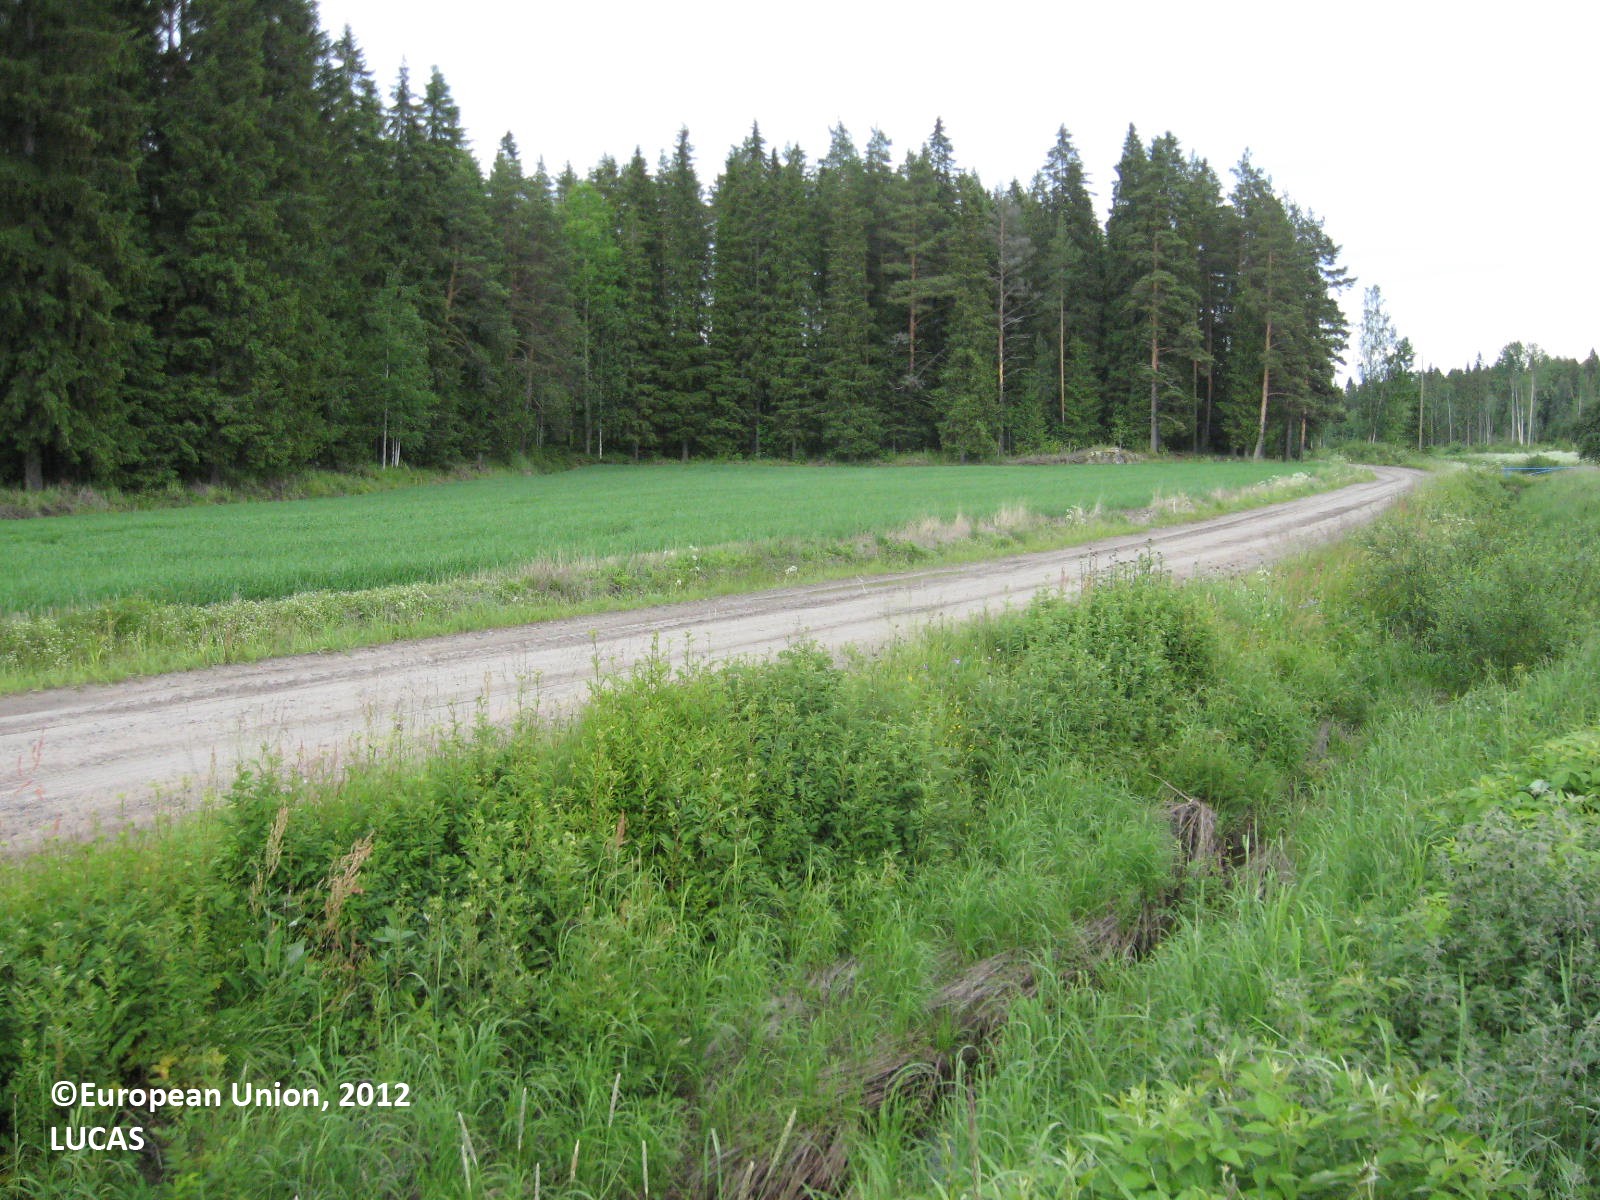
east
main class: Cropland
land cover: Barley
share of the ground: > 75 %
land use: Agriculture (excluding fallow land and kitchen gardens)
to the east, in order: Barley; Ditches and canals; Tracks; Grassland without tree/shrub cover; Ditches and canals; Electric lines; Shruby margins; Paved roads, cycling and walking lanes; Grass margins; Ditches and canals; Grassland without tree/shrub cover
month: June
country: FI
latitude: 62.9197
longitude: 22.6358
